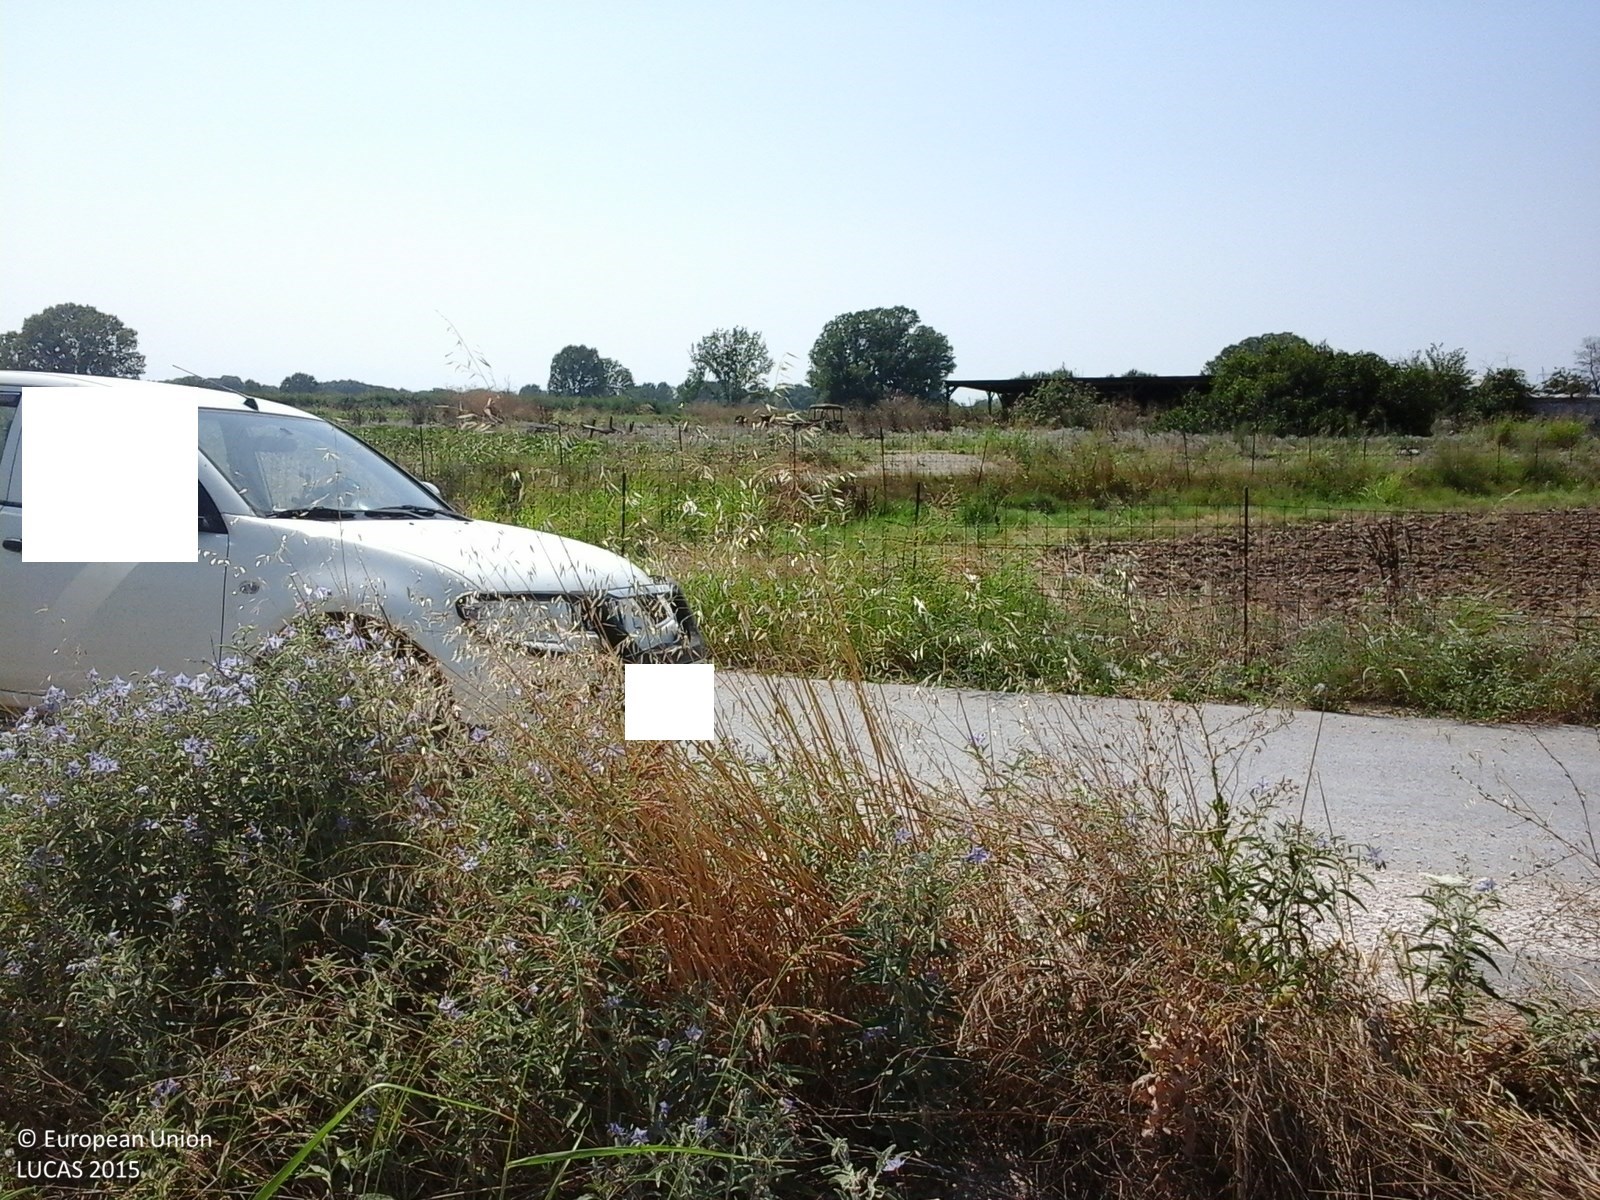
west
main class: Grassland
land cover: Spontaneously vegetated surfaces
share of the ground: > 75 %
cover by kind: herbaceous plants 100 %
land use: Fallow land
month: July
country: GR
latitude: 40.7204
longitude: 22.6843
